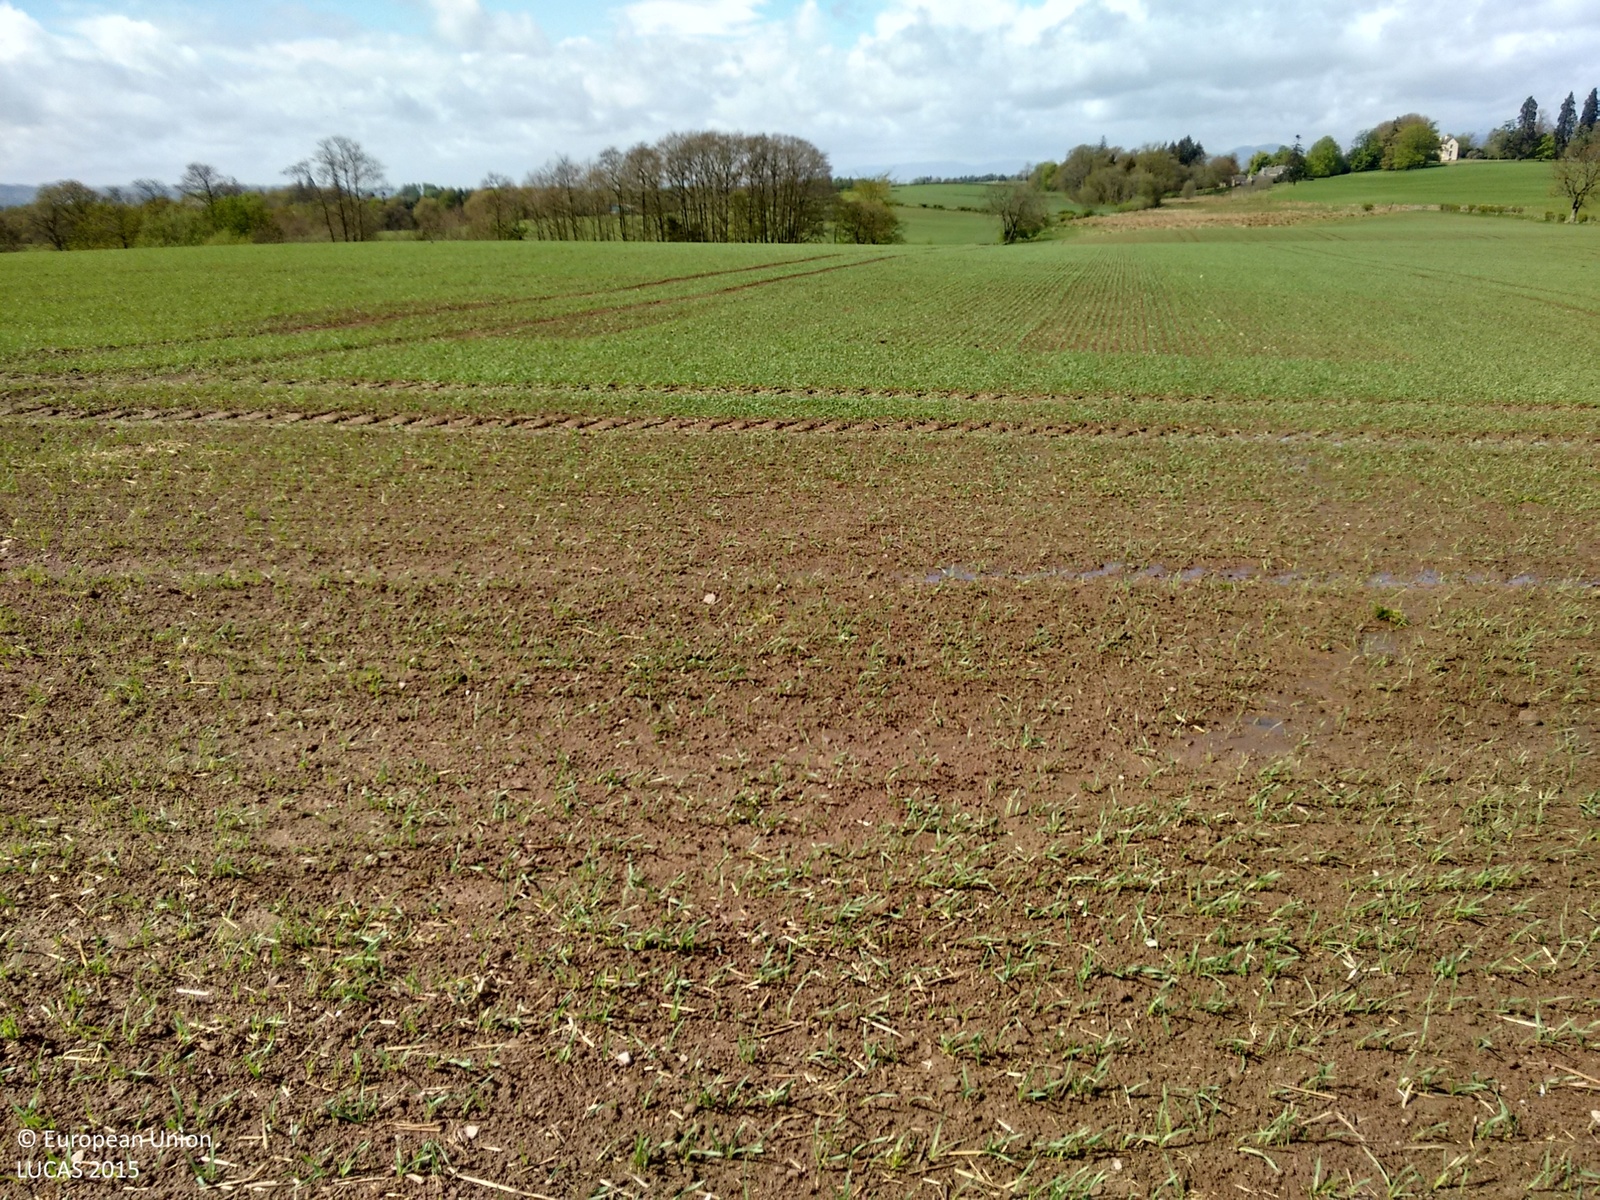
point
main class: Cropland
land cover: Barley
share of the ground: 25 - 50 %
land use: Agriculture (excluding fallow land and kitchen gardens)
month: May
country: GB
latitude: 56.1734
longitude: -4.0853
